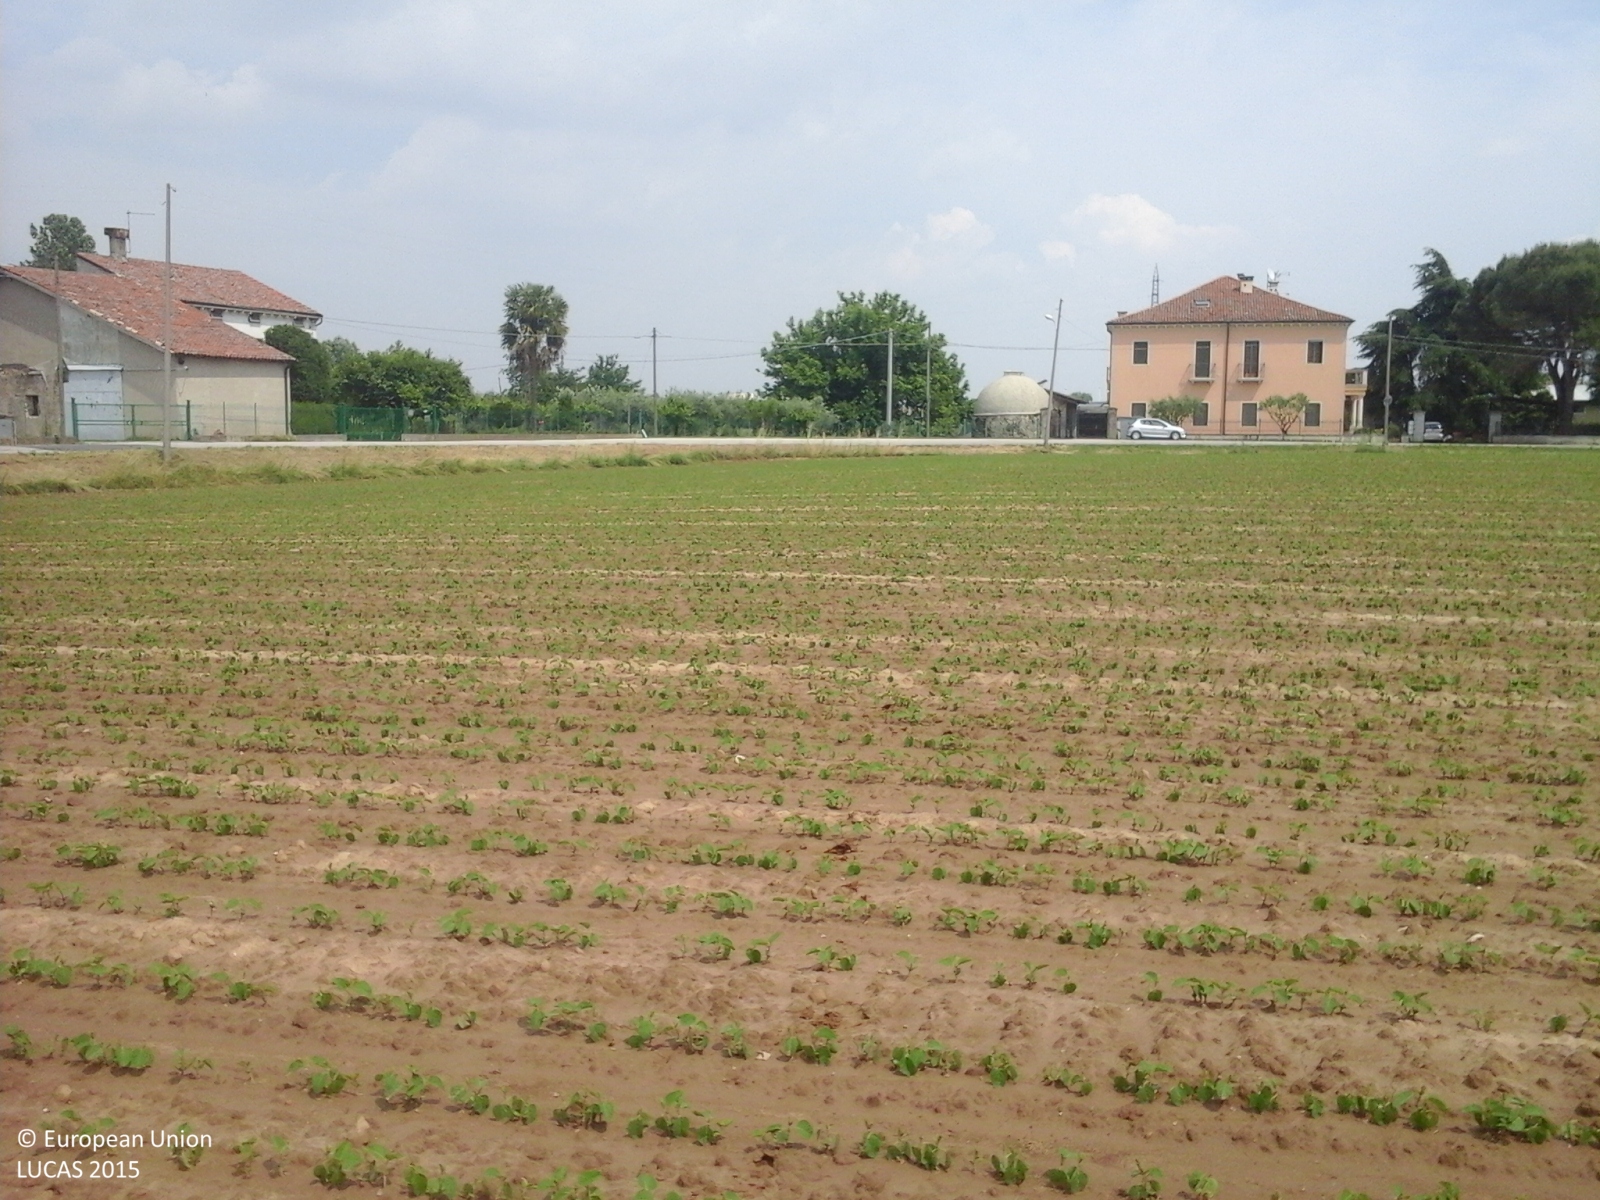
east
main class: Cropland
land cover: Soya
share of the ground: < 10 %
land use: Agriculture (excluding fallow land and kitchen gardens)
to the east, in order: Soya; Grassland without tree/shrub cover; Paved roads, cycling and walking lanes; Electric lines; Olive groves; Grassland without tree/shrub cover; Single bushes/trees; Grassland without tree/shrub cover; Other fresh vegetables; Fences; Maize; Soya
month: May
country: IT
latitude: 45.4559
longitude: 11.6213
